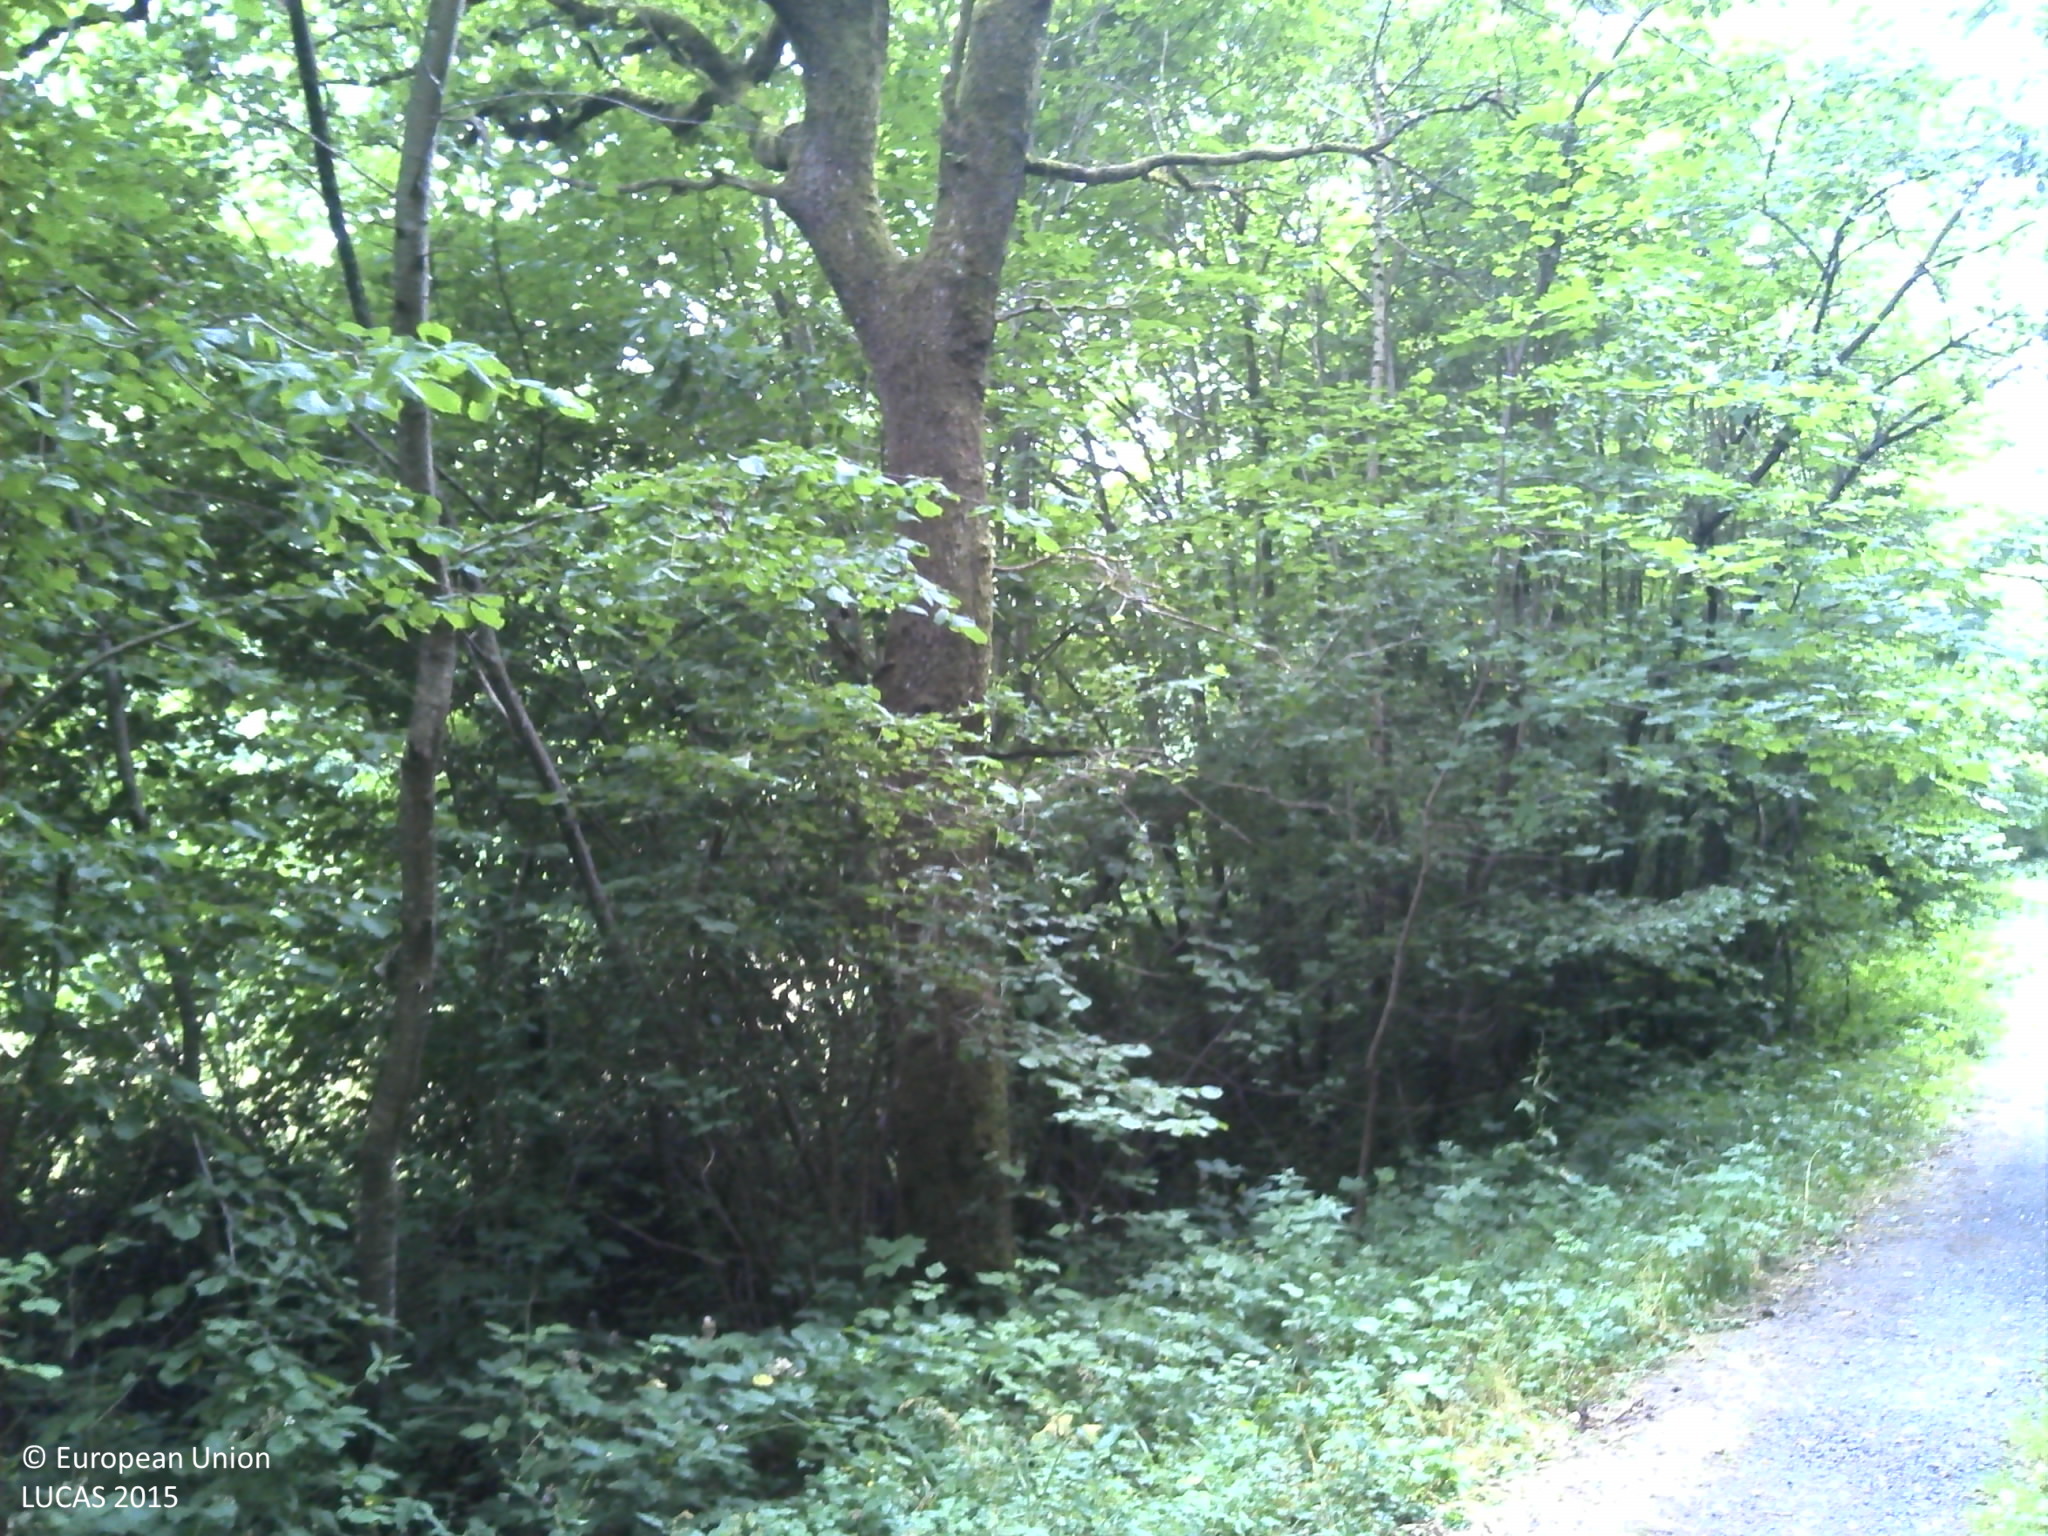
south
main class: Woodland
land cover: Broadleaved woodland
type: mesophytic deciduous forest
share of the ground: > 75 %
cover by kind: broadleaved forest trees 70 %, herbaceous plants 25 %, consolidated bare surface 5 %
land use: Forestry
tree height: > 5 m
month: July
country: FR
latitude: 49.8319
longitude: 4.8113
